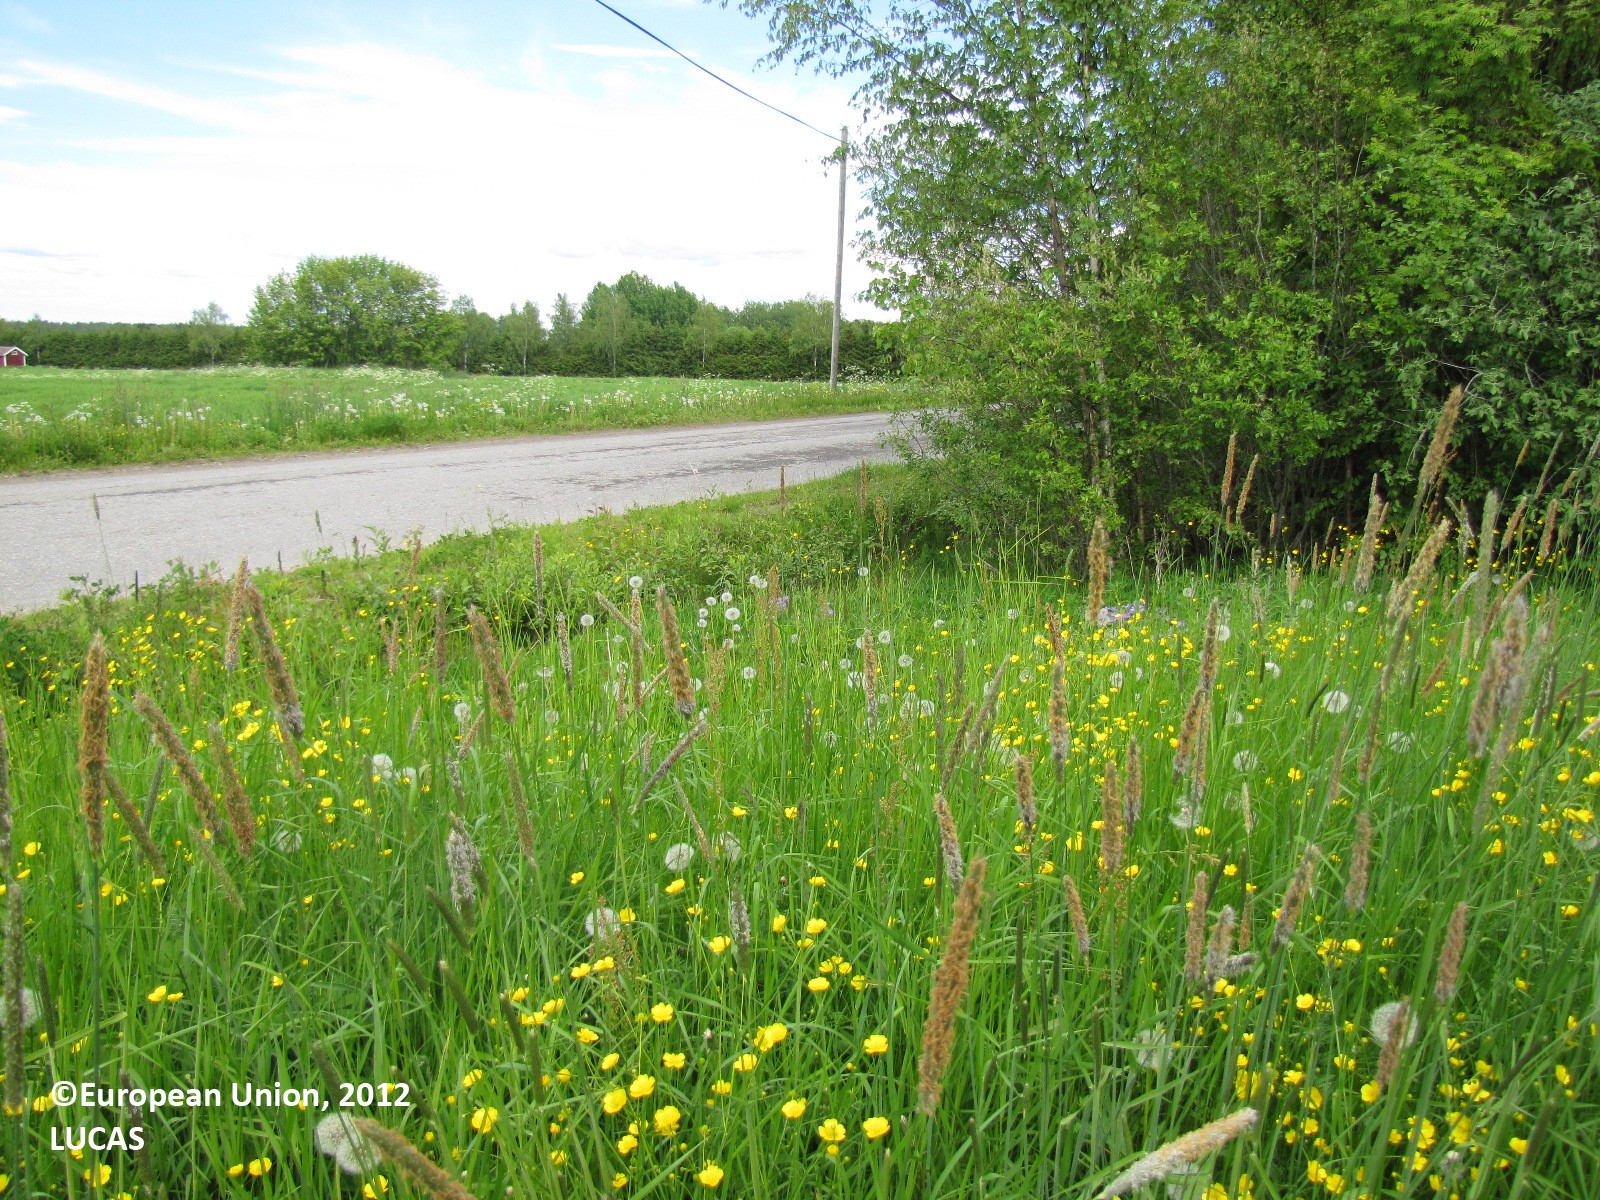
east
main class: Grassland
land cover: Grassland without tree/shrub cover
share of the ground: > 75 %
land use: Residential
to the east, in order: Grassland without tree/shrub cover; Ditches and canals; Grass margins; Paved roads, cycling and walking lanes; Grass margins; Ditches and canals; Temporary grasslands; Grass margins; Tracks; Grass margins; Electric lines; Temporary grasslands; Ditches and canals; Grass margins; Tracks; Grass margins; Lines of trees; Temporary grasslands
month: June
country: FI
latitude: 61.4830
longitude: 24.3086
